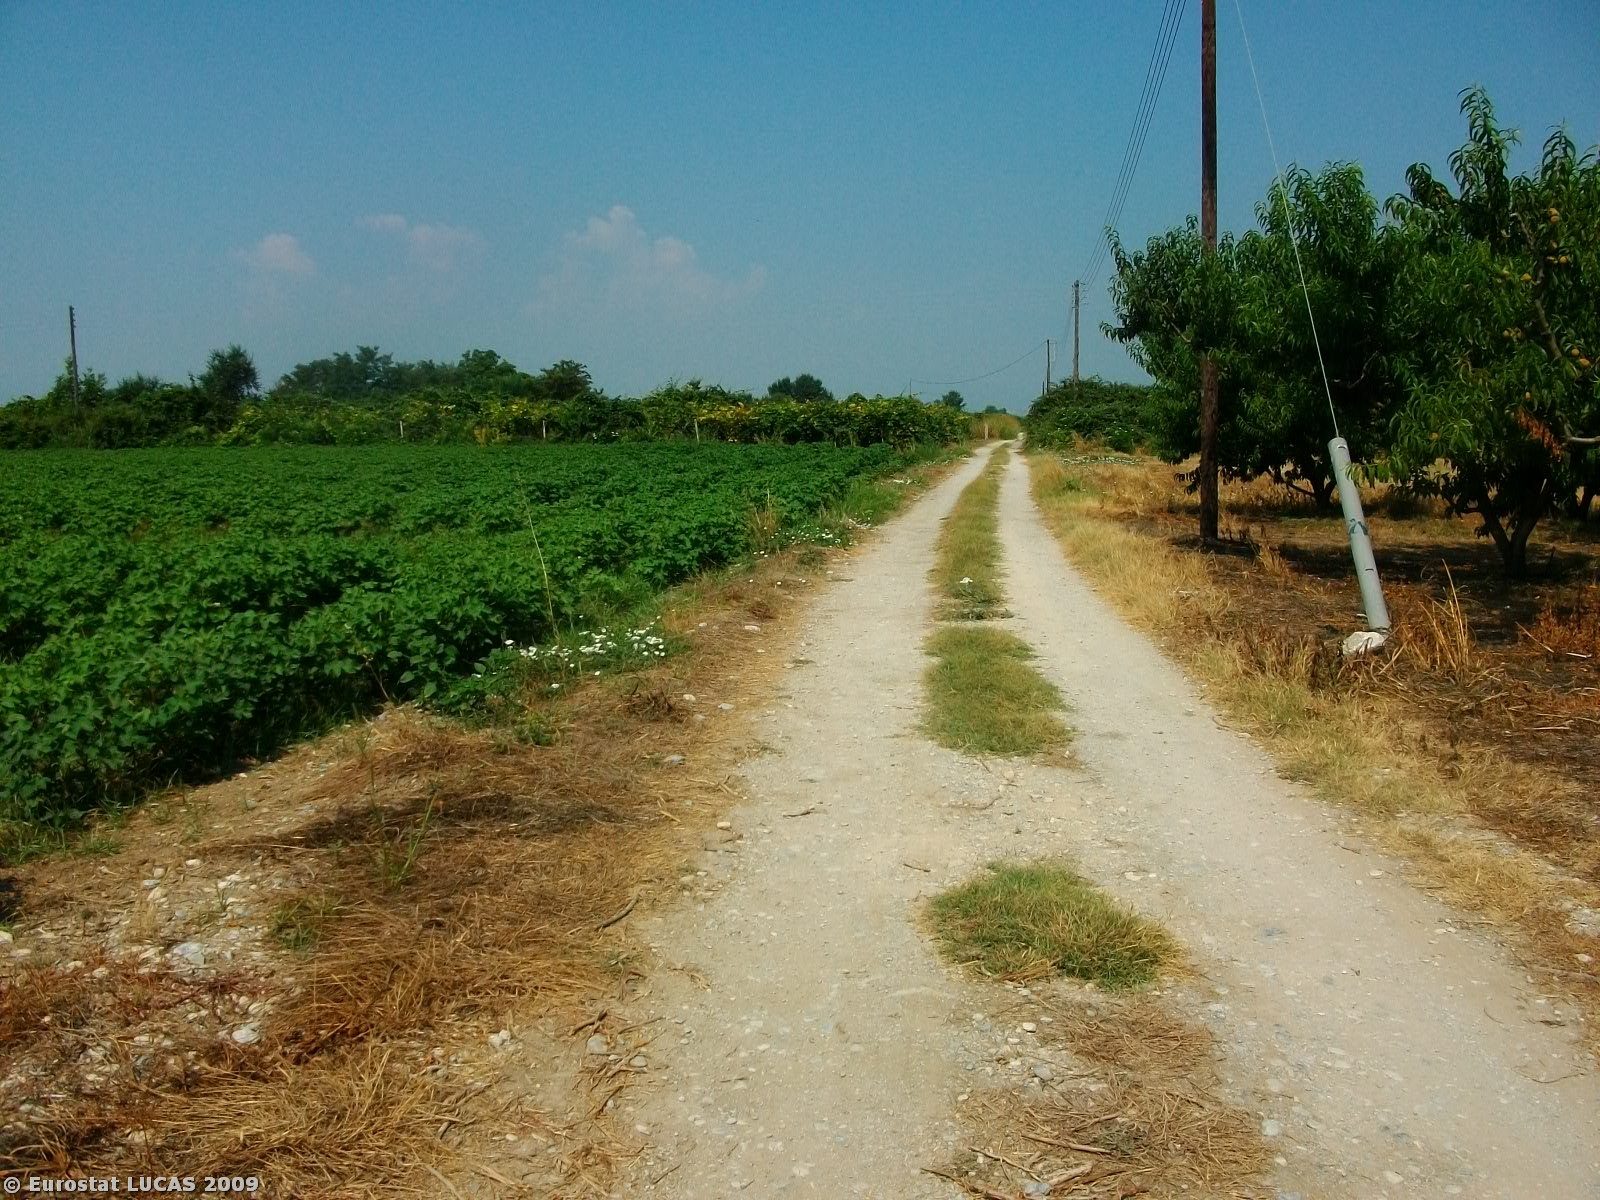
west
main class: Artificial land
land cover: Non built-up linear features
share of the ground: > 75 %
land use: Road transport
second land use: Agriculture (excluding fallow land and kitchen gardens)
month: July
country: GR
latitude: 40.2929
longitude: 22.5983
